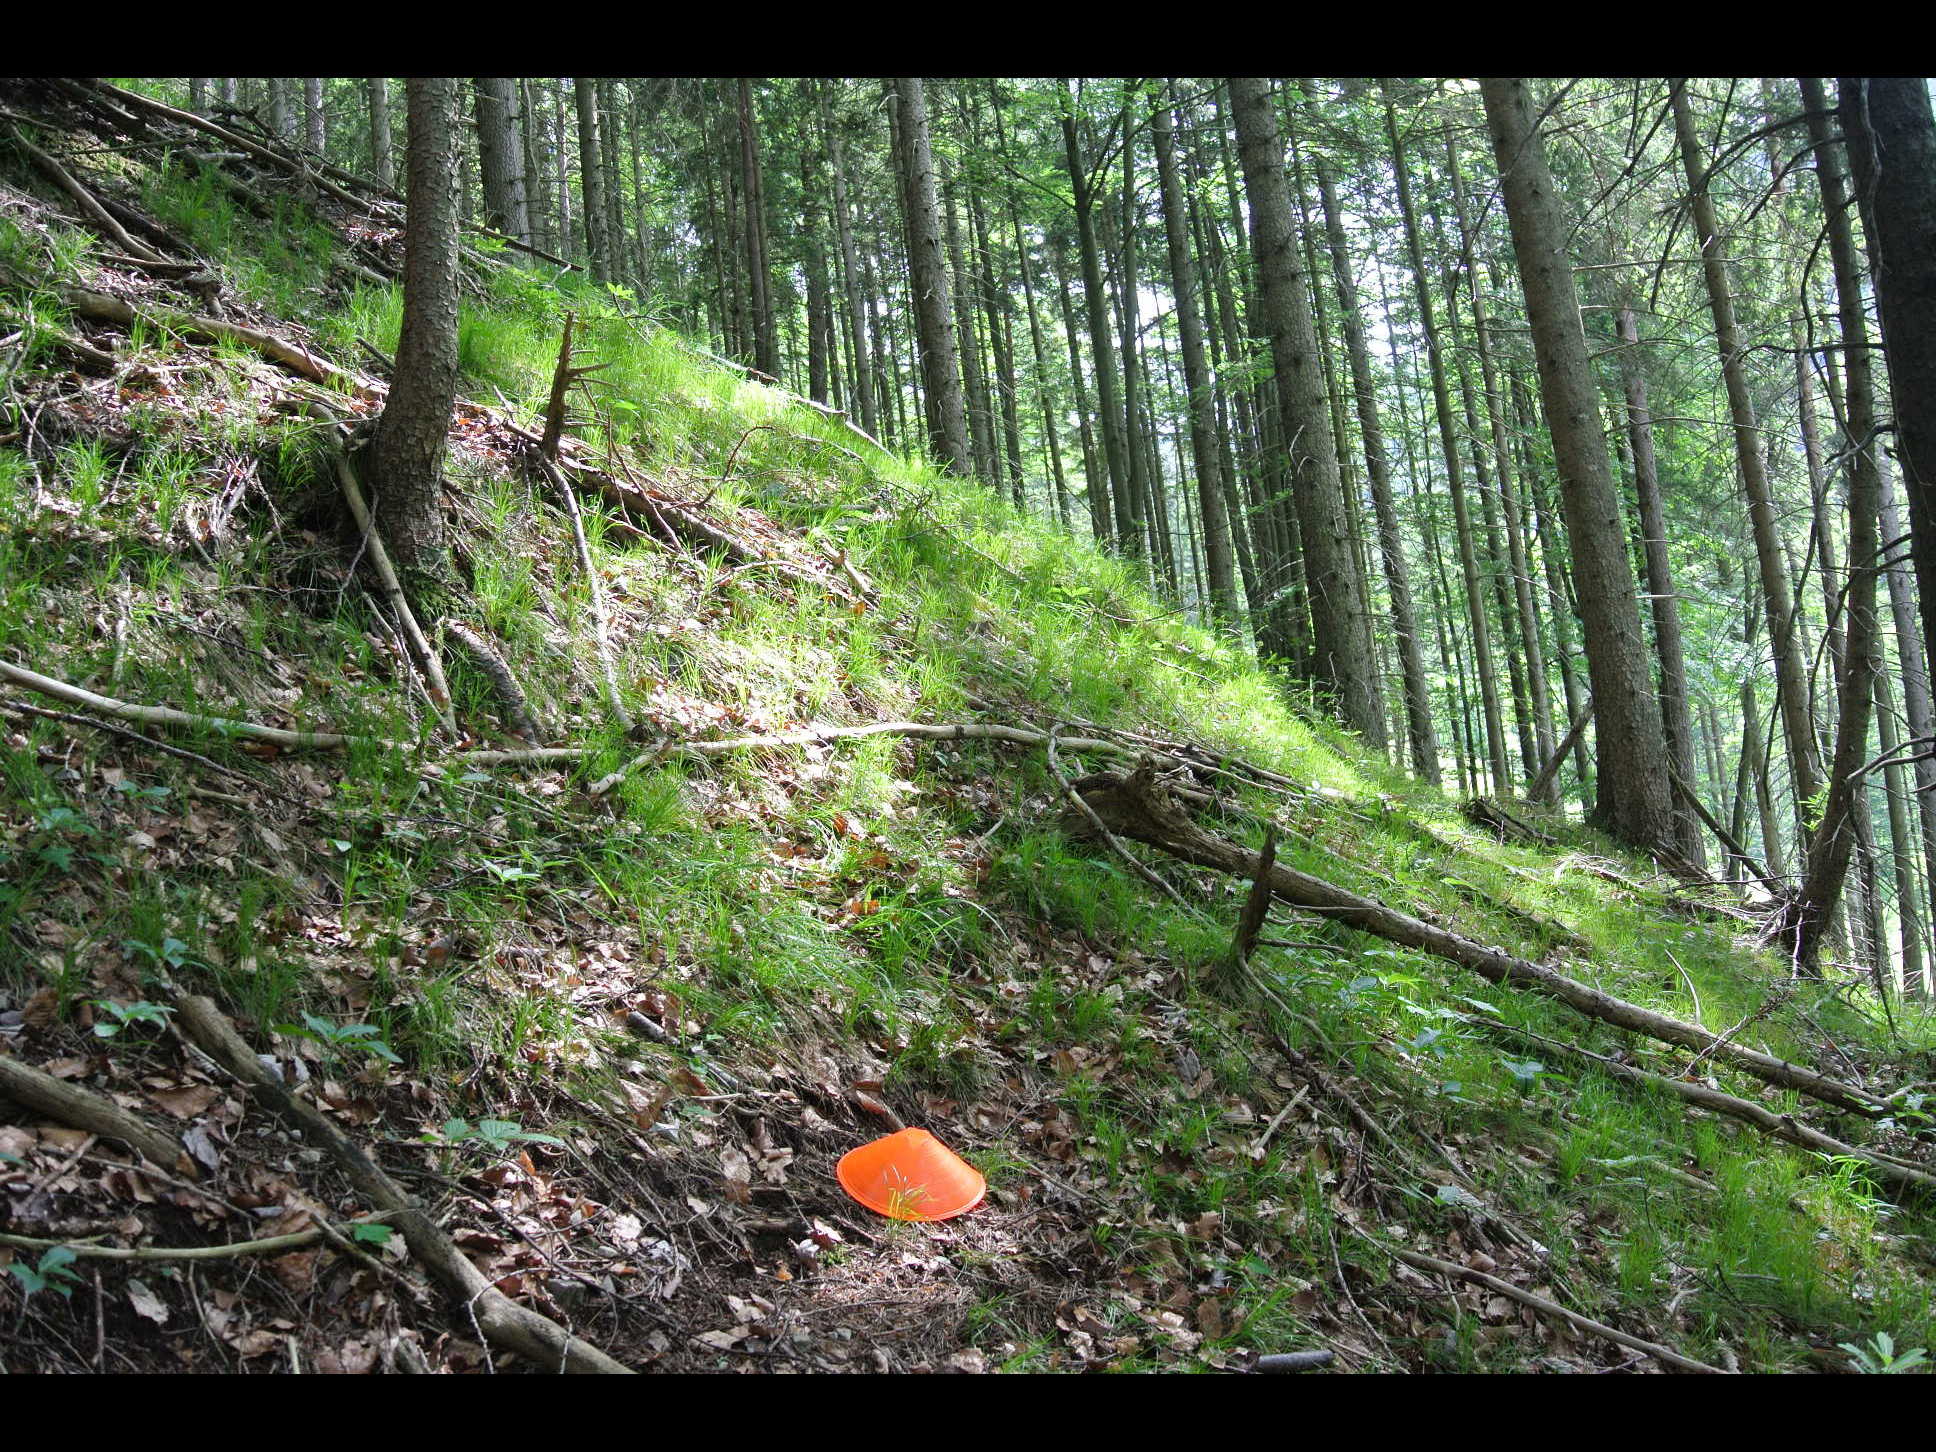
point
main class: Woodland
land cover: Spruce dominated mixed woodland
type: alpine coniferous forest
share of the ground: > 75 %
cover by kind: coniferous forest trees 75 %, broadleaved forest trees 25 %
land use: Forestry
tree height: > 5 m
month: May
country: AT
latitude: 47.9460
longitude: 15.7731
